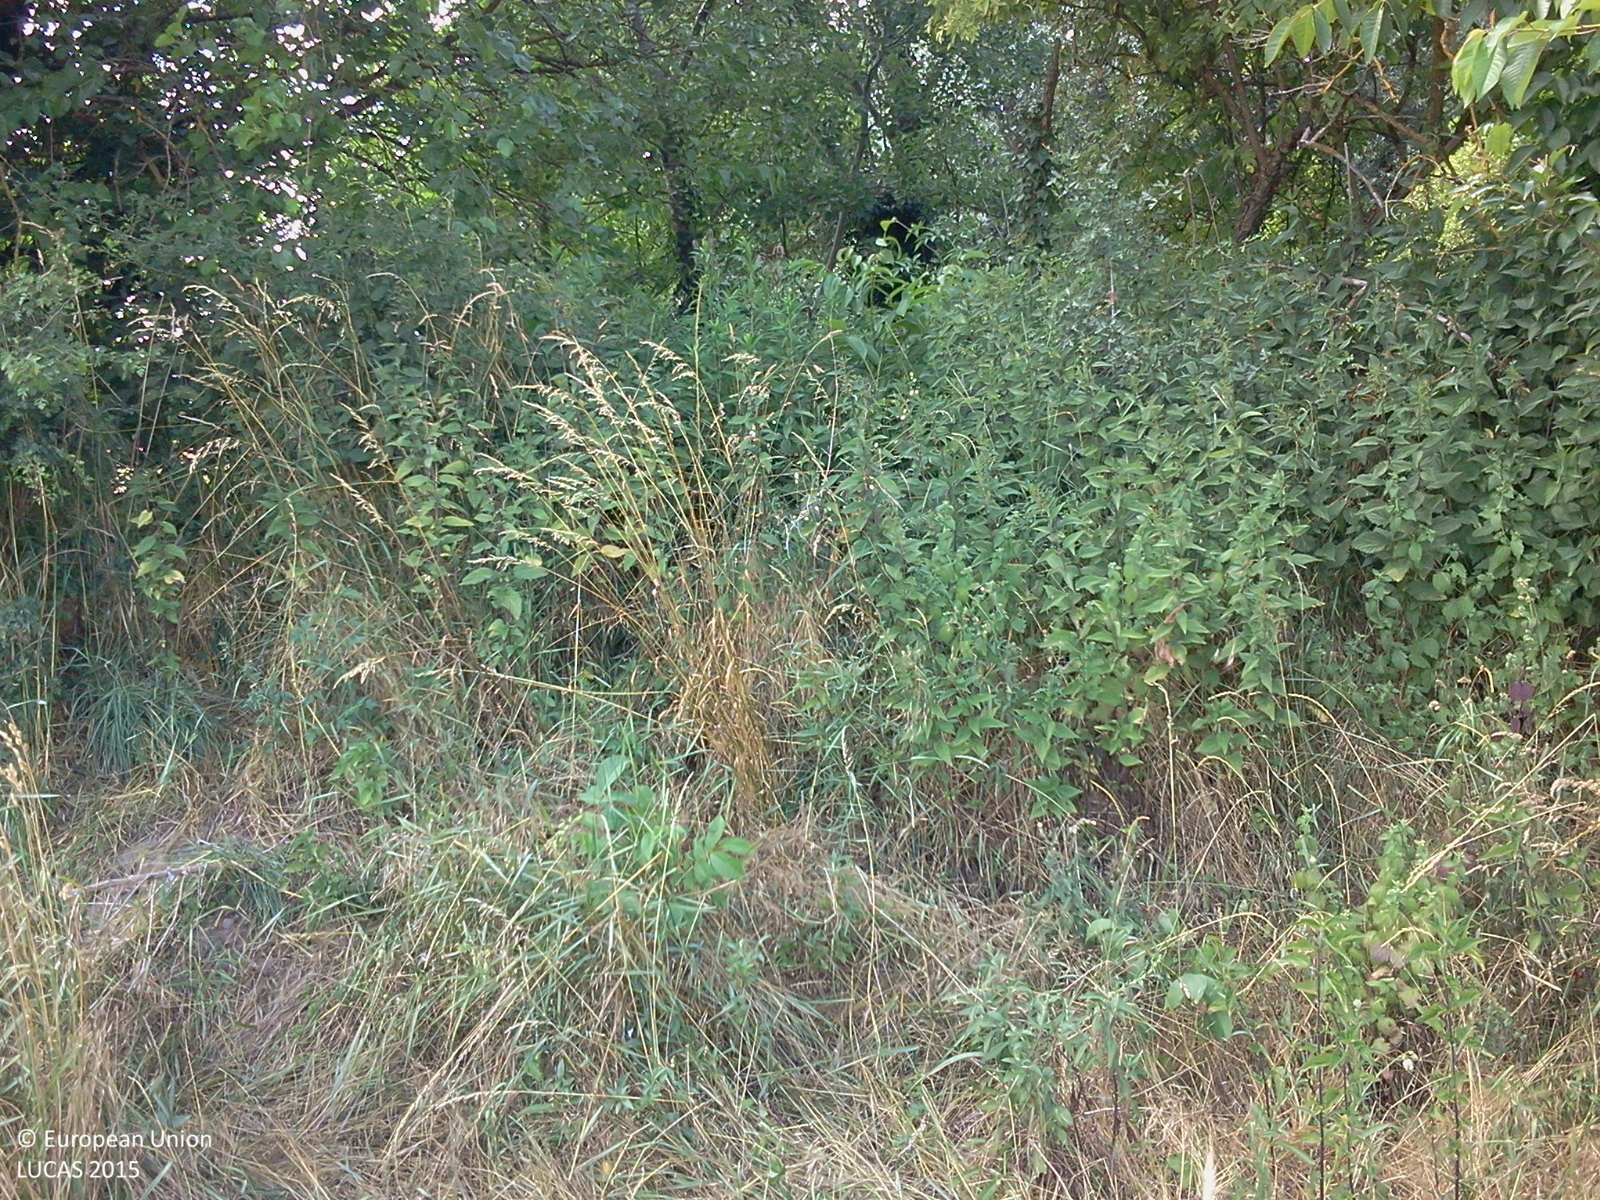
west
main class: Cropland
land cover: Barley
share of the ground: > 75 %
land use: Agriculture (excluding fallow land and kitchen gardens)
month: June
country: HU
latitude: 46.9279
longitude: 17.1098
